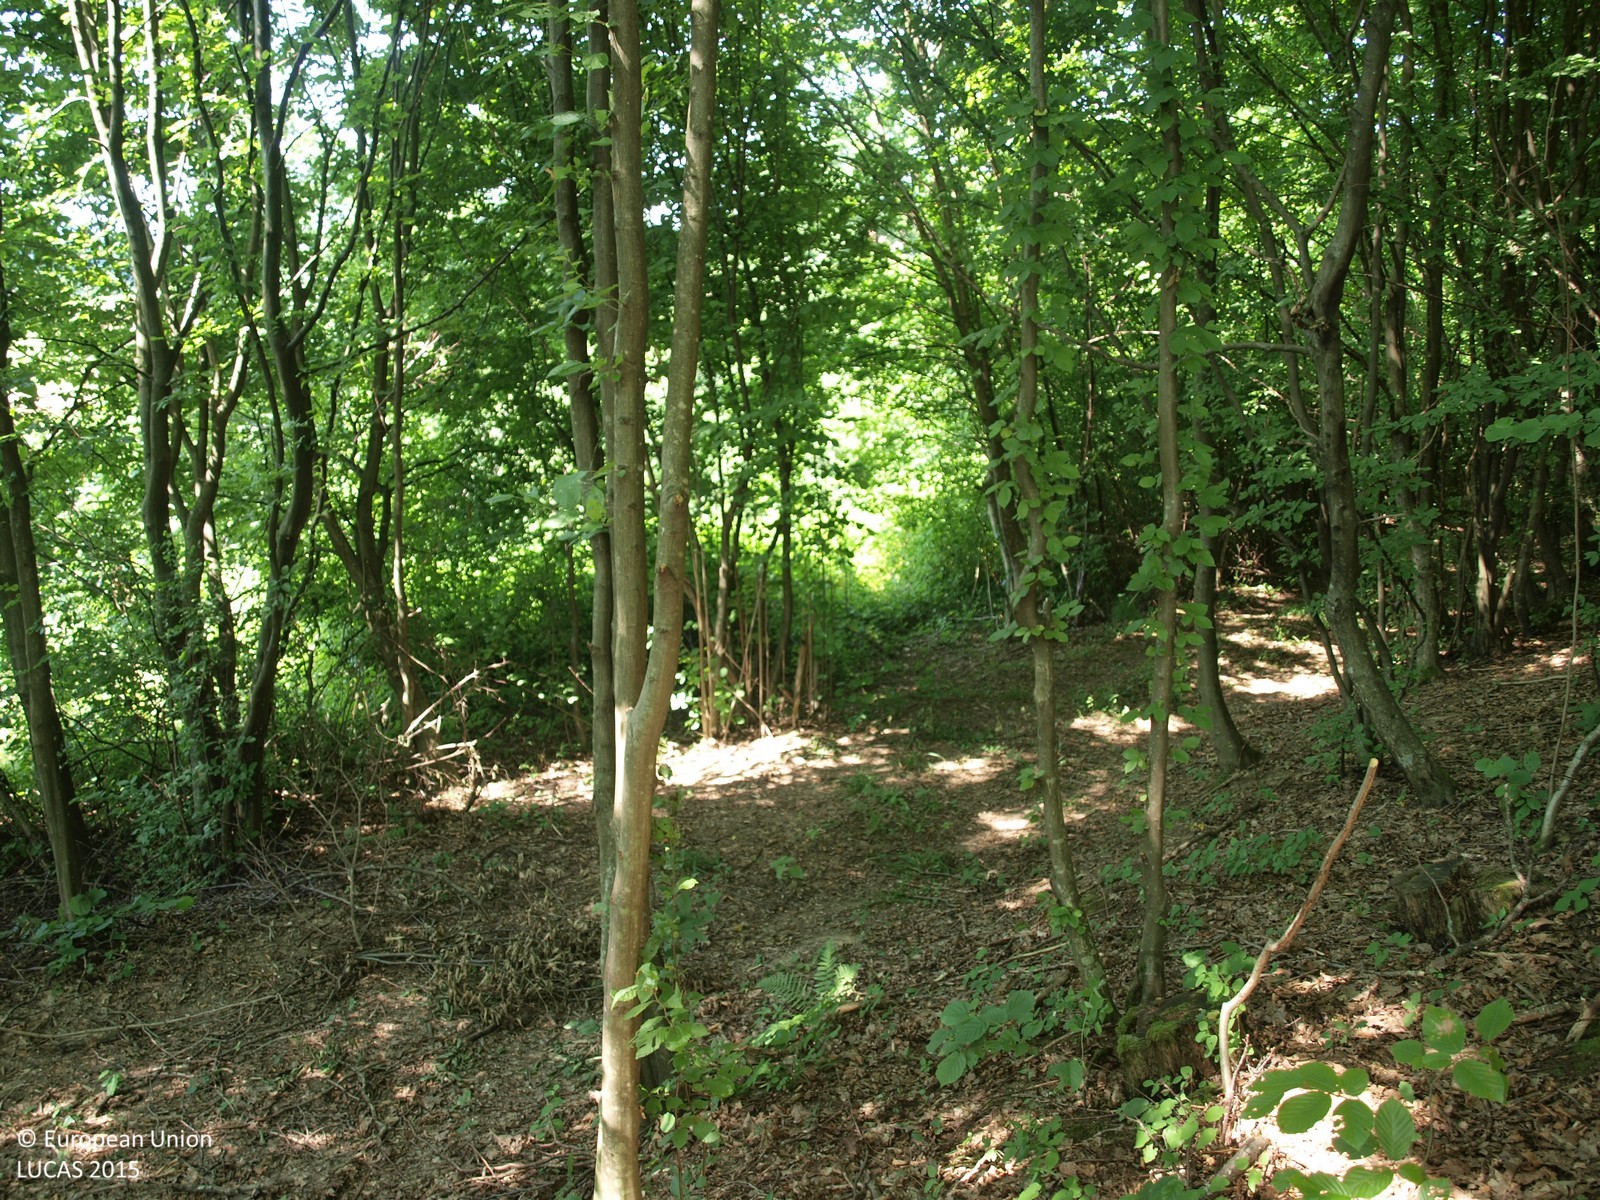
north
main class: Woodland
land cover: Broadleaved woodland
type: beech forest
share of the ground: > 75 %
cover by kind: broadleaved forest trees 100 %
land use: Forestry
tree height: > 5 m
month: July
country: HR
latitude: 45.7096
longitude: 15.7390
